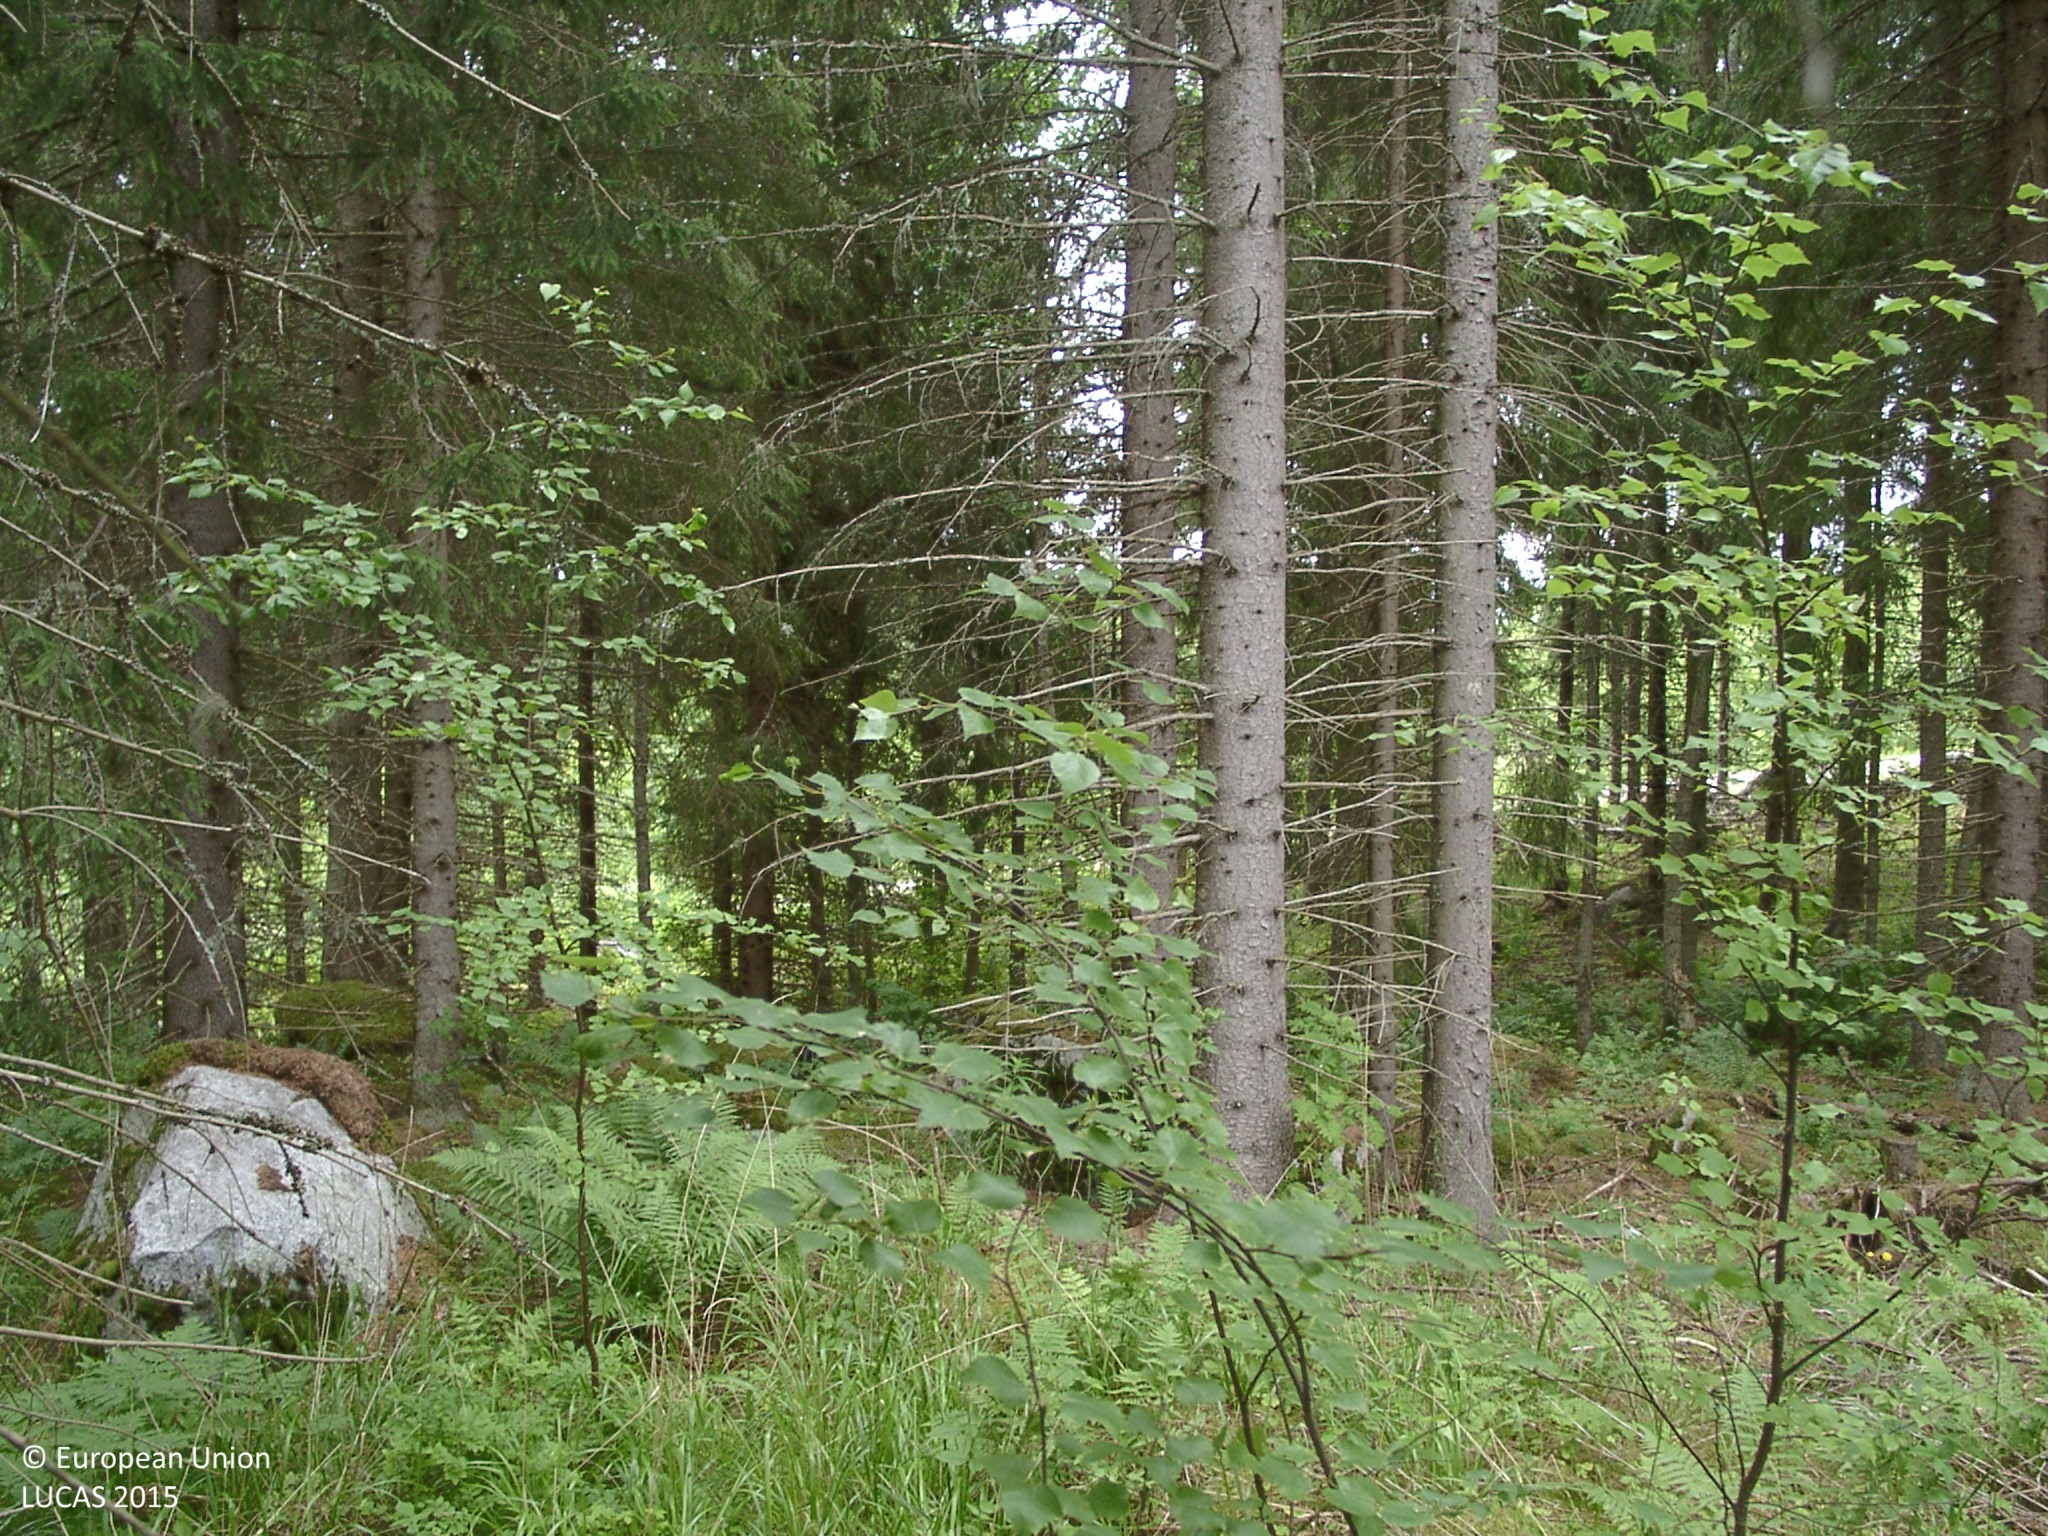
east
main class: Woodland
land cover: Spruce dominated coniferous woodland
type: boreal forest
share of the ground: > 75 %
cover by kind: coniferous forest trees 75 %, lichens and mosses 10 %, broadleaved forest trees 5 %, shrubs 5 %, herbaceous plants 5 %
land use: Forestry
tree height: > 5 m
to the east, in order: Spruce dominated coniferous woodland; Rocks and stones; Ditches and canals; Paved roads, cycling and walking lanes; Grass margins; Spruce dominated mixed woodland; Shrubland with sparse tree cover; Grassland with sparse tree/shrub cover; Other mixed woodland; Rivers and streams; Grassland with sparse tree/shrub cover; Spruce dominated coniferous woodland; Shruby margins; Tracks; Shruby margins; Broadleaved woodland; Shrubland with sparse tree cover; Pine dominated mixed woodland
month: July
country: FI
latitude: 61.5022
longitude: 25.2008
